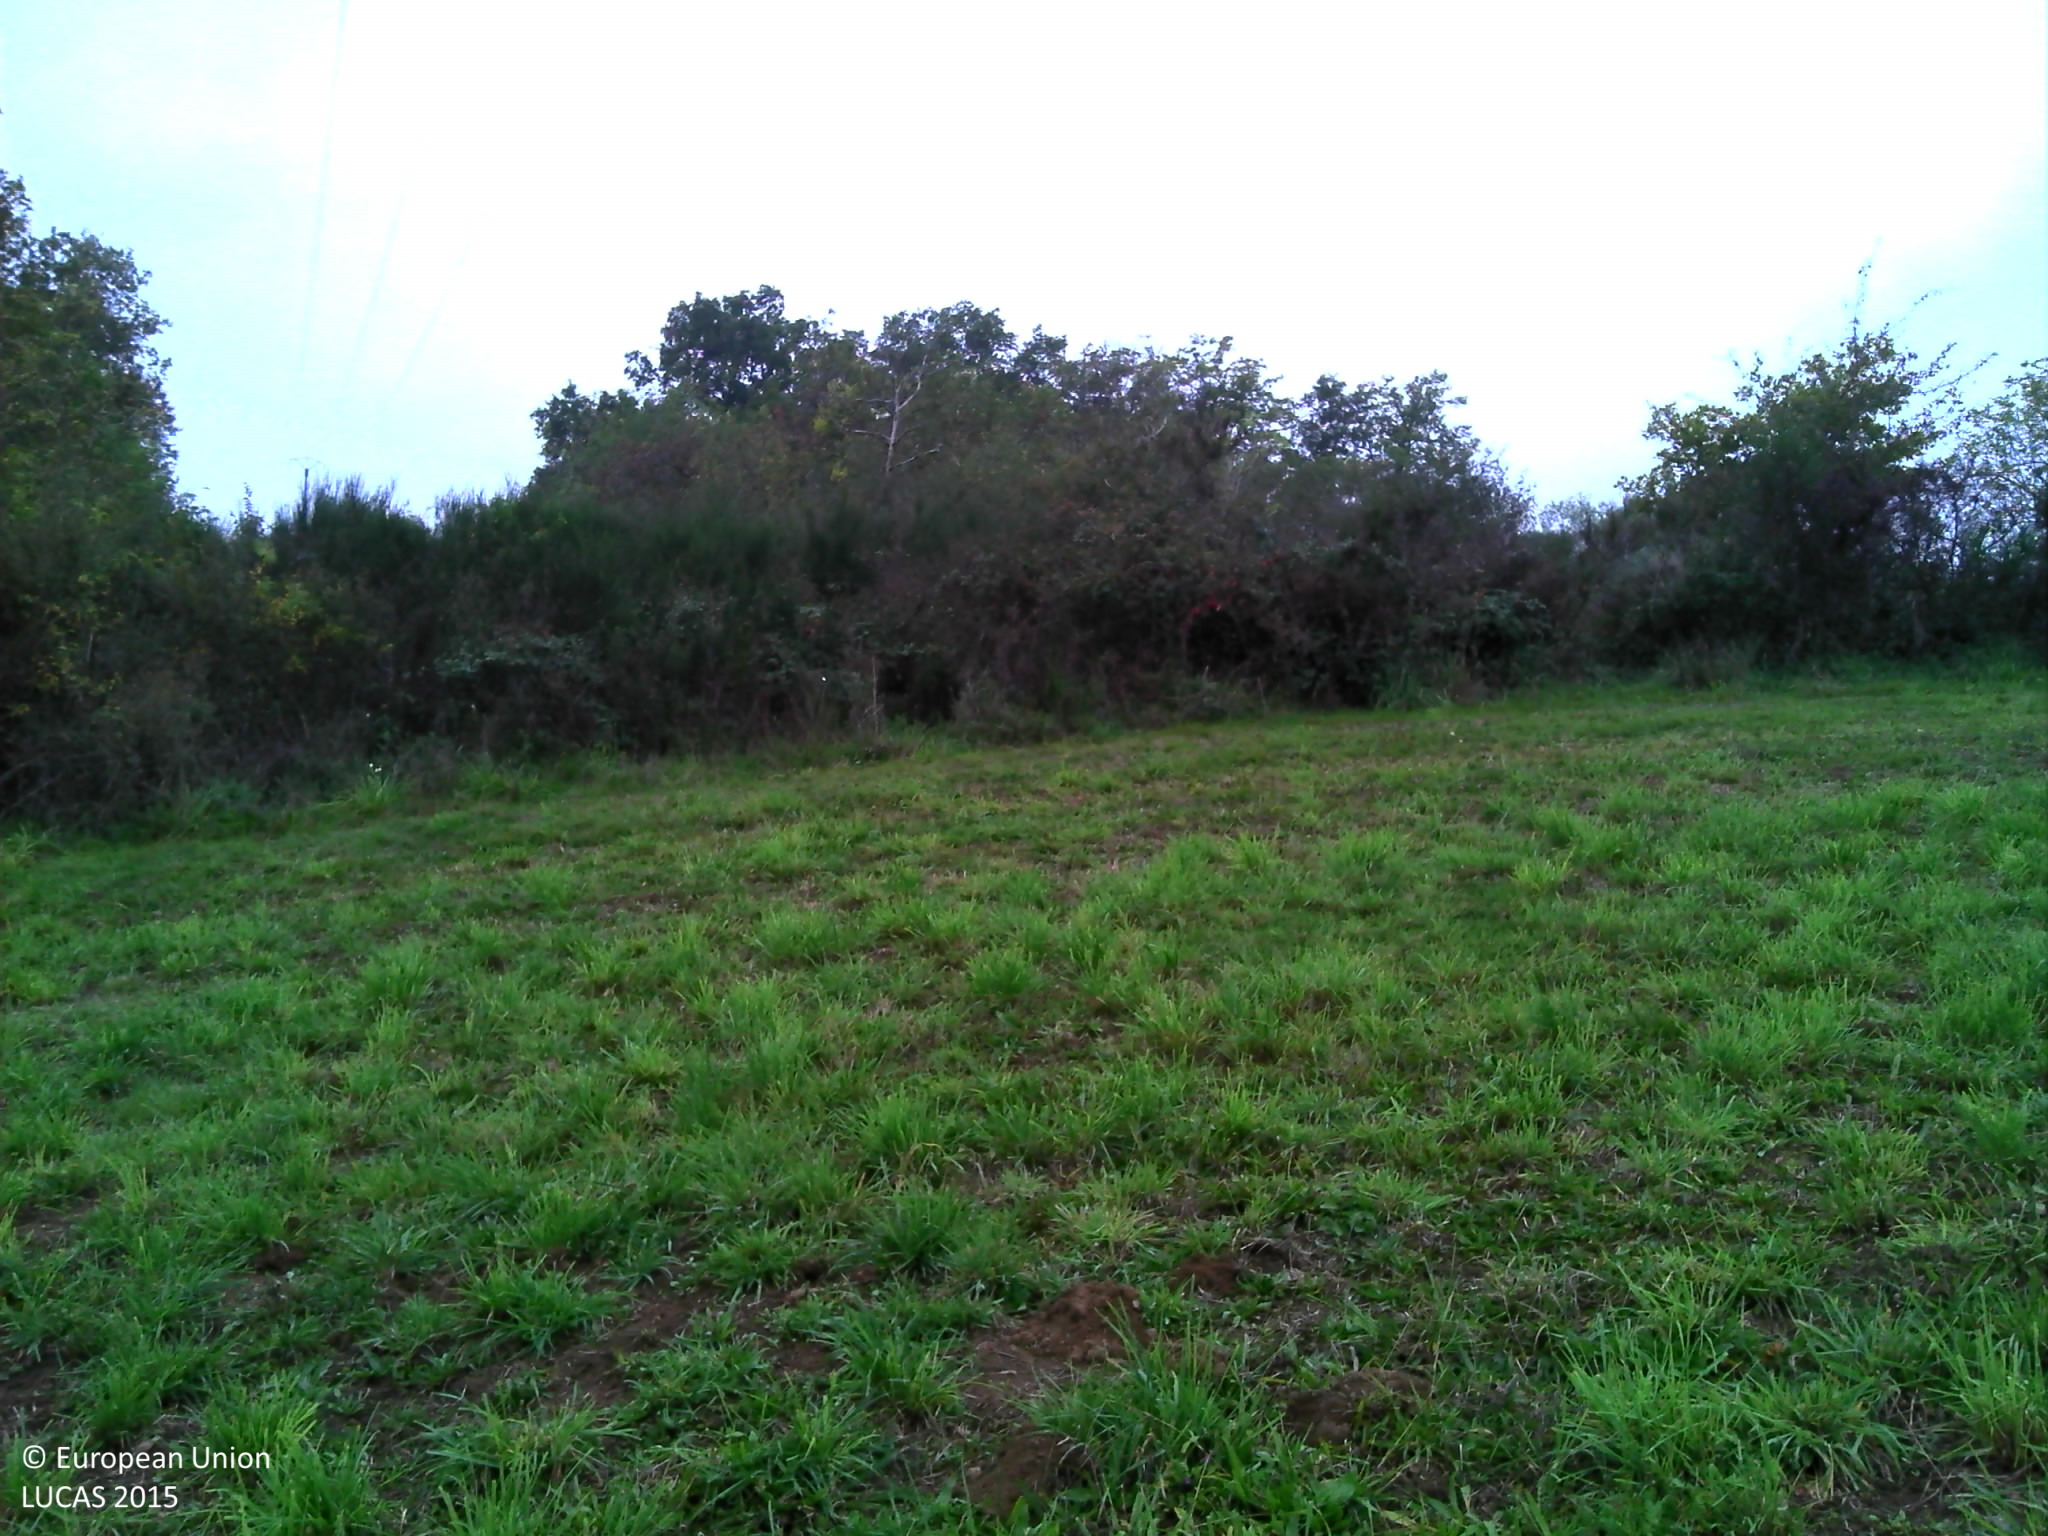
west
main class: Grassland
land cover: Grassland without tree/shrub cover
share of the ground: > 75 %
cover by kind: herbaceous plants 90 %, unconsolidated bare surface 10 %
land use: Agriculture (excluding fallow land and kitchen gardens)
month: October
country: FR
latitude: 46.0174
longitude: 3.0627
